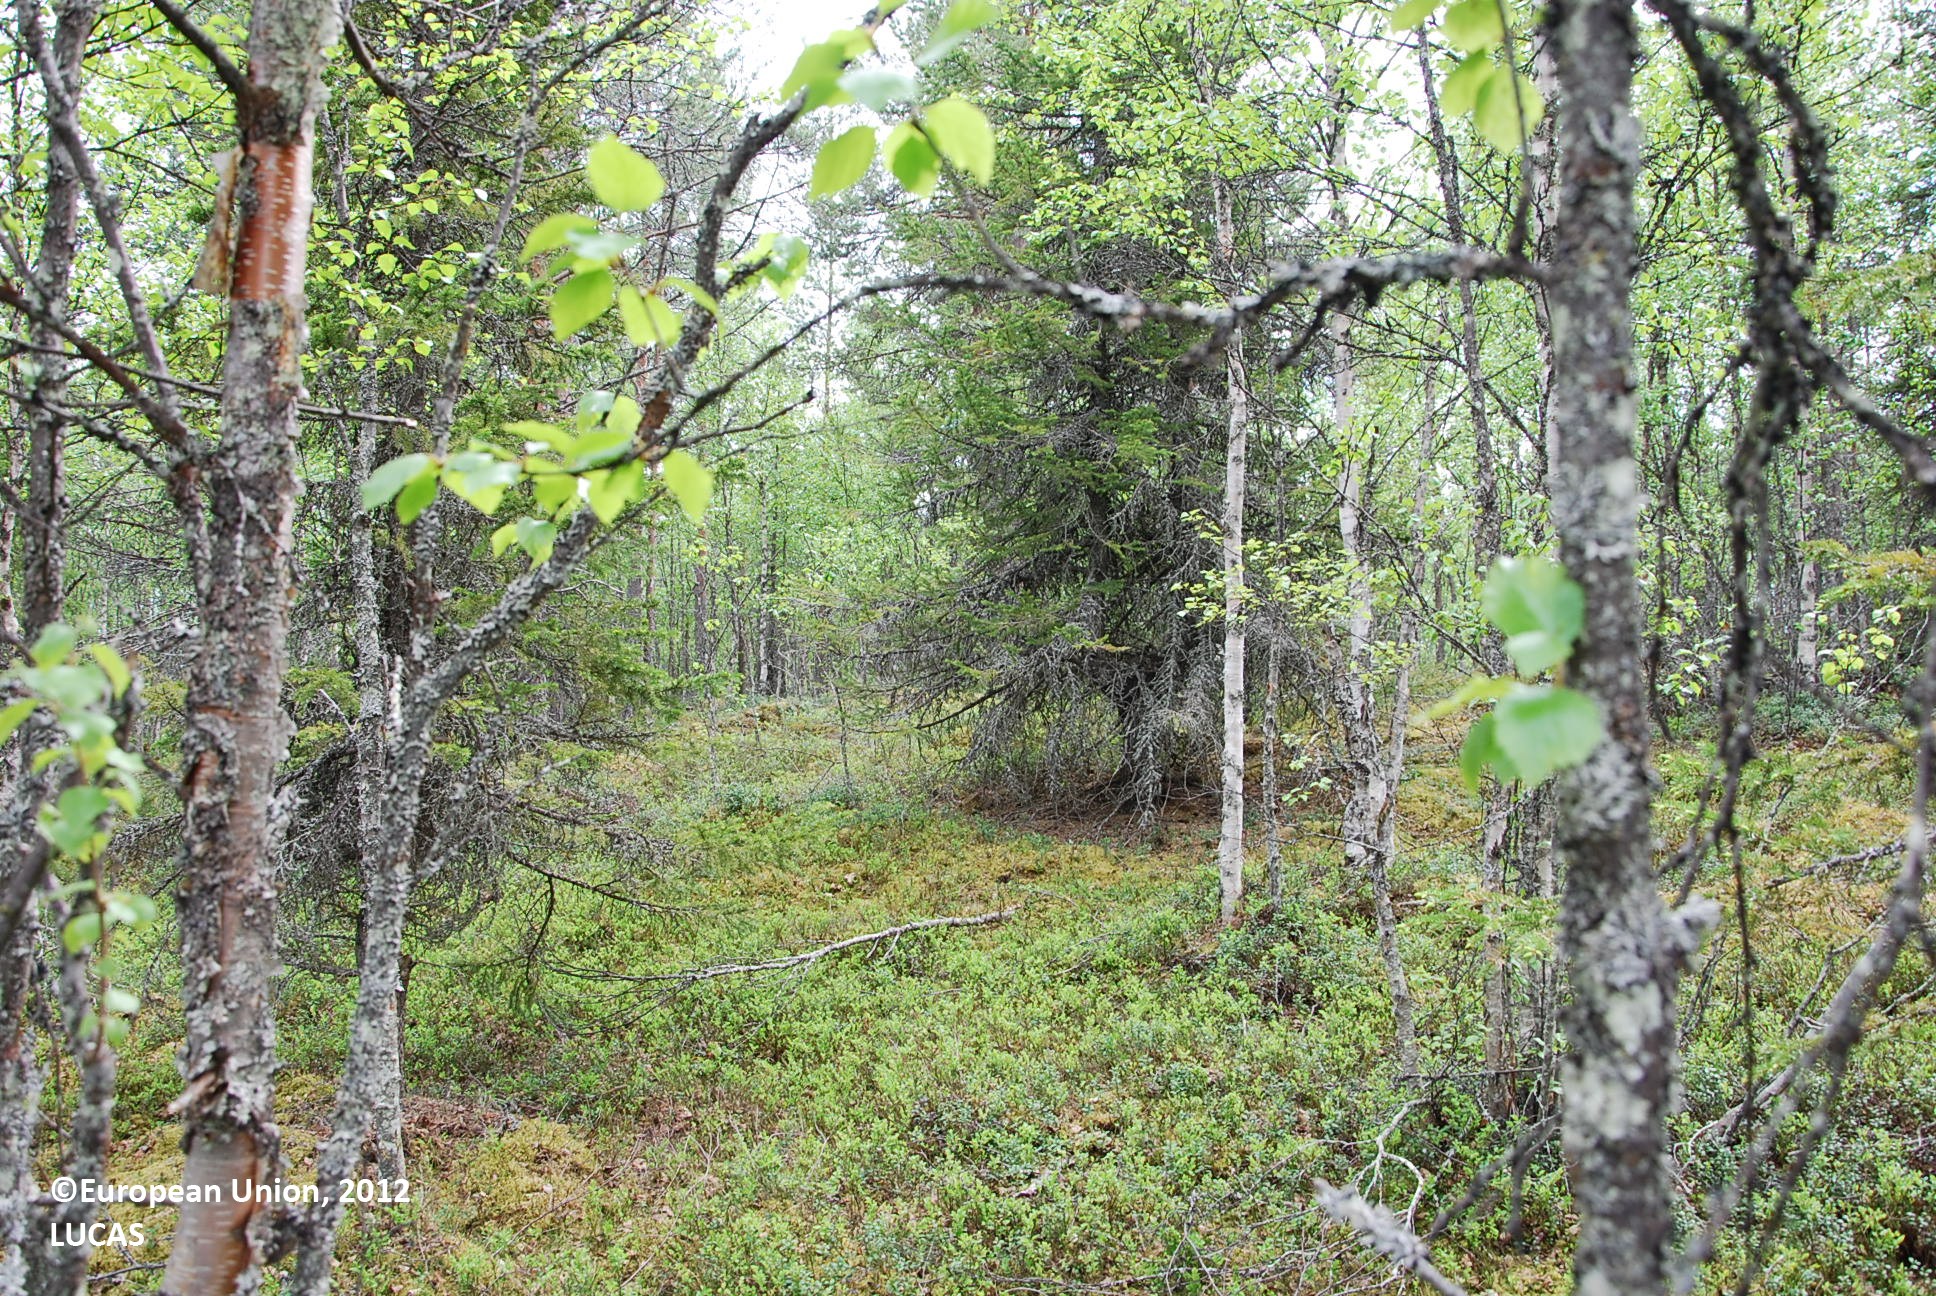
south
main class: Woodland
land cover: Pine dominated mixed woodland
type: boreal forest
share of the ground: > 75 %
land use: Forestry
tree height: > 5 m
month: June
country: FI
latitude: 66.0406
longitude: 27.6708
